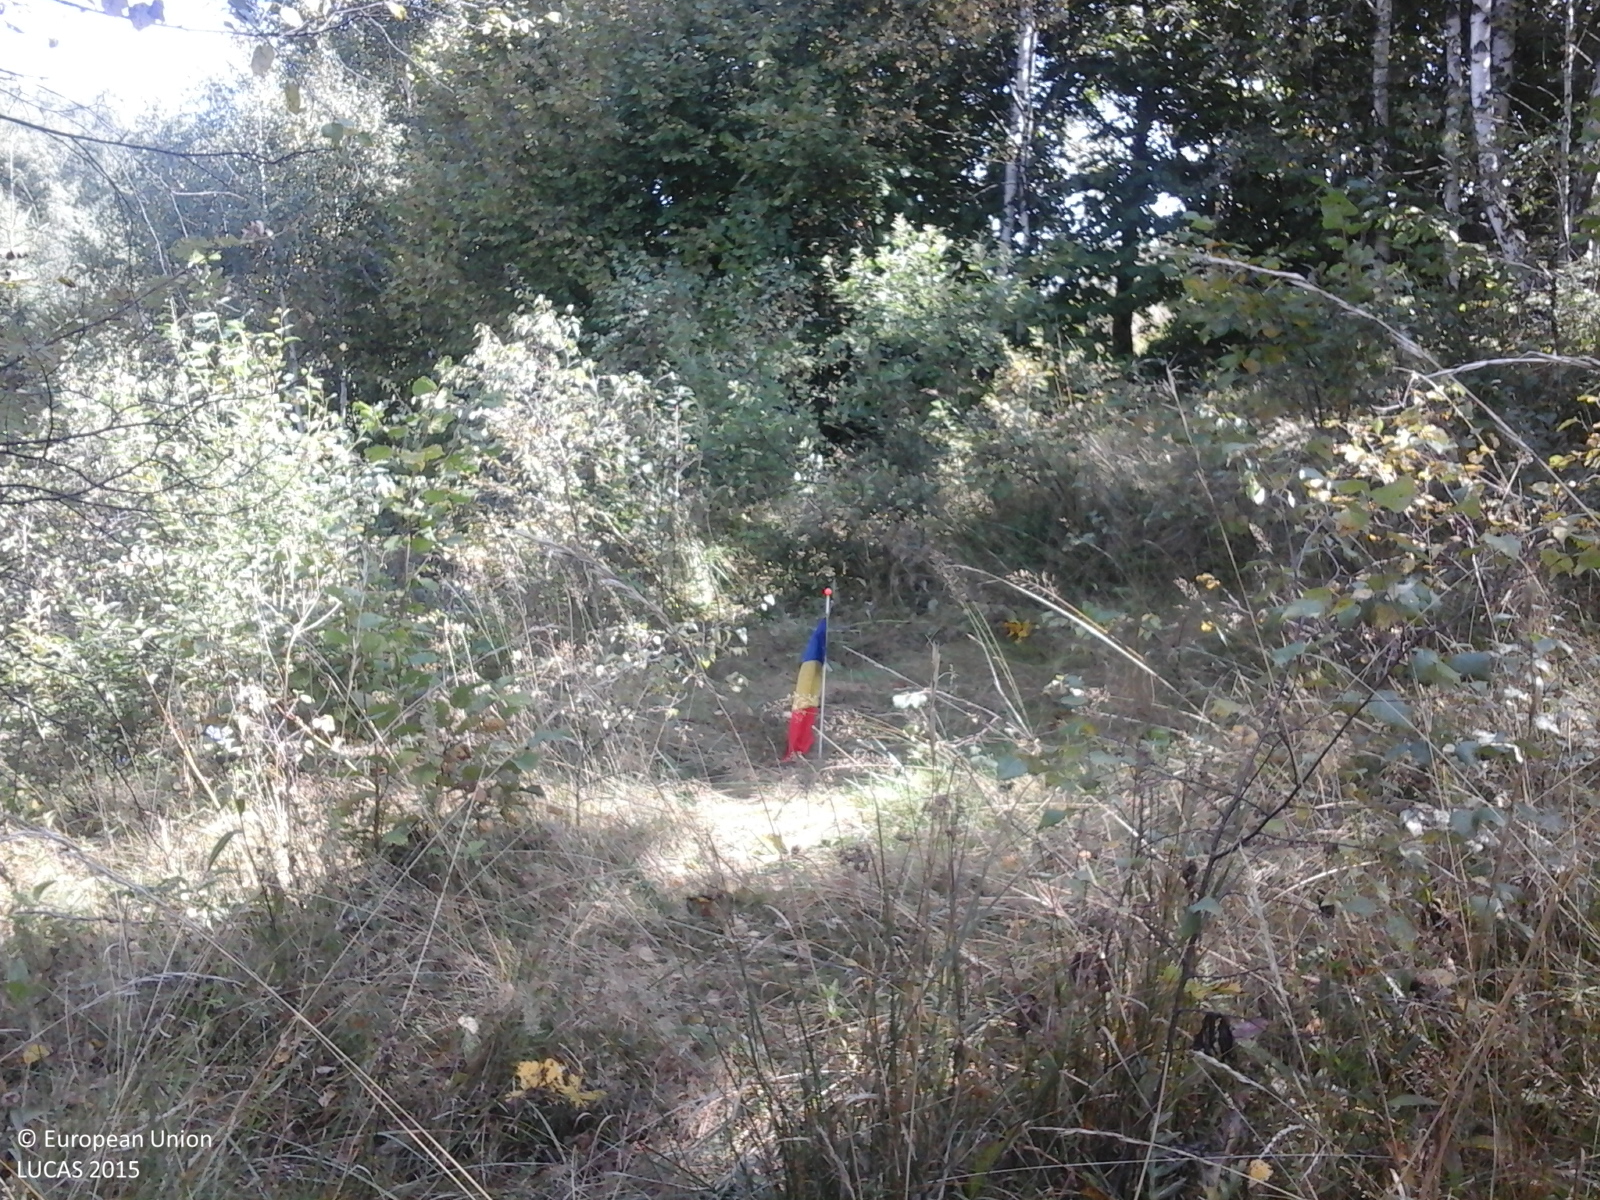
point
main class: Woodland
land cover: Spruce dominated mixed woodland
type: alpine coniferous forest
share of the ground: > 75 %
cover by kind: coniferous forest trees 50 %, broadleaved forest trees 40 %, shrubs 5 %, herbaceous plants 5 %
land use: Forestry
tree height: > 5 m
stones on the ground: < 10 %
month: September
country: RO
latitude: 46.7290
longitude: 23.0818
